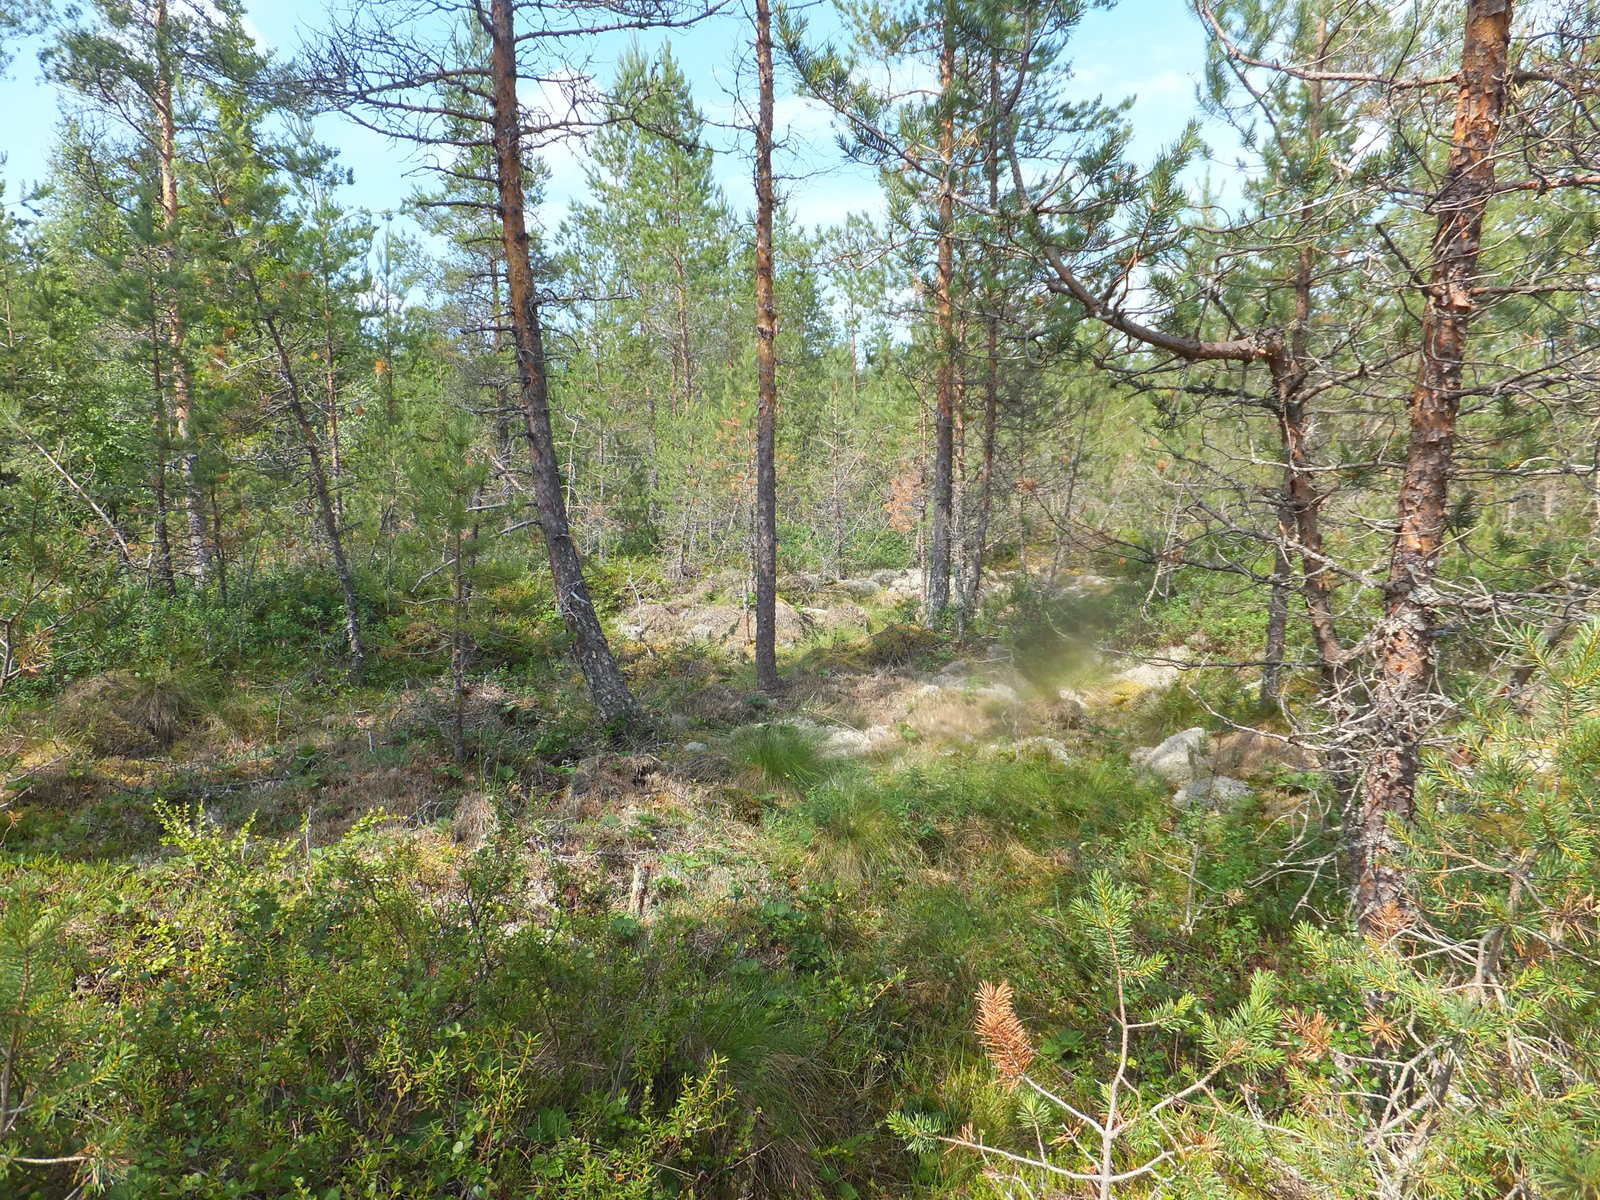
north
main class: Woodland
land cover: Pine dominated coniferous woodland
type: boreal forest
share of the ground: 25 - 50 %
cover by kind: coniferous forest trees 30 %, shrubs 30 %, lichens and mosses 30 %, herbaceous plants 10 %
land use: Forestry
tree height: < 5 m
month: July
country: FI
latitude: 63.5823
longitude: 23.2527
